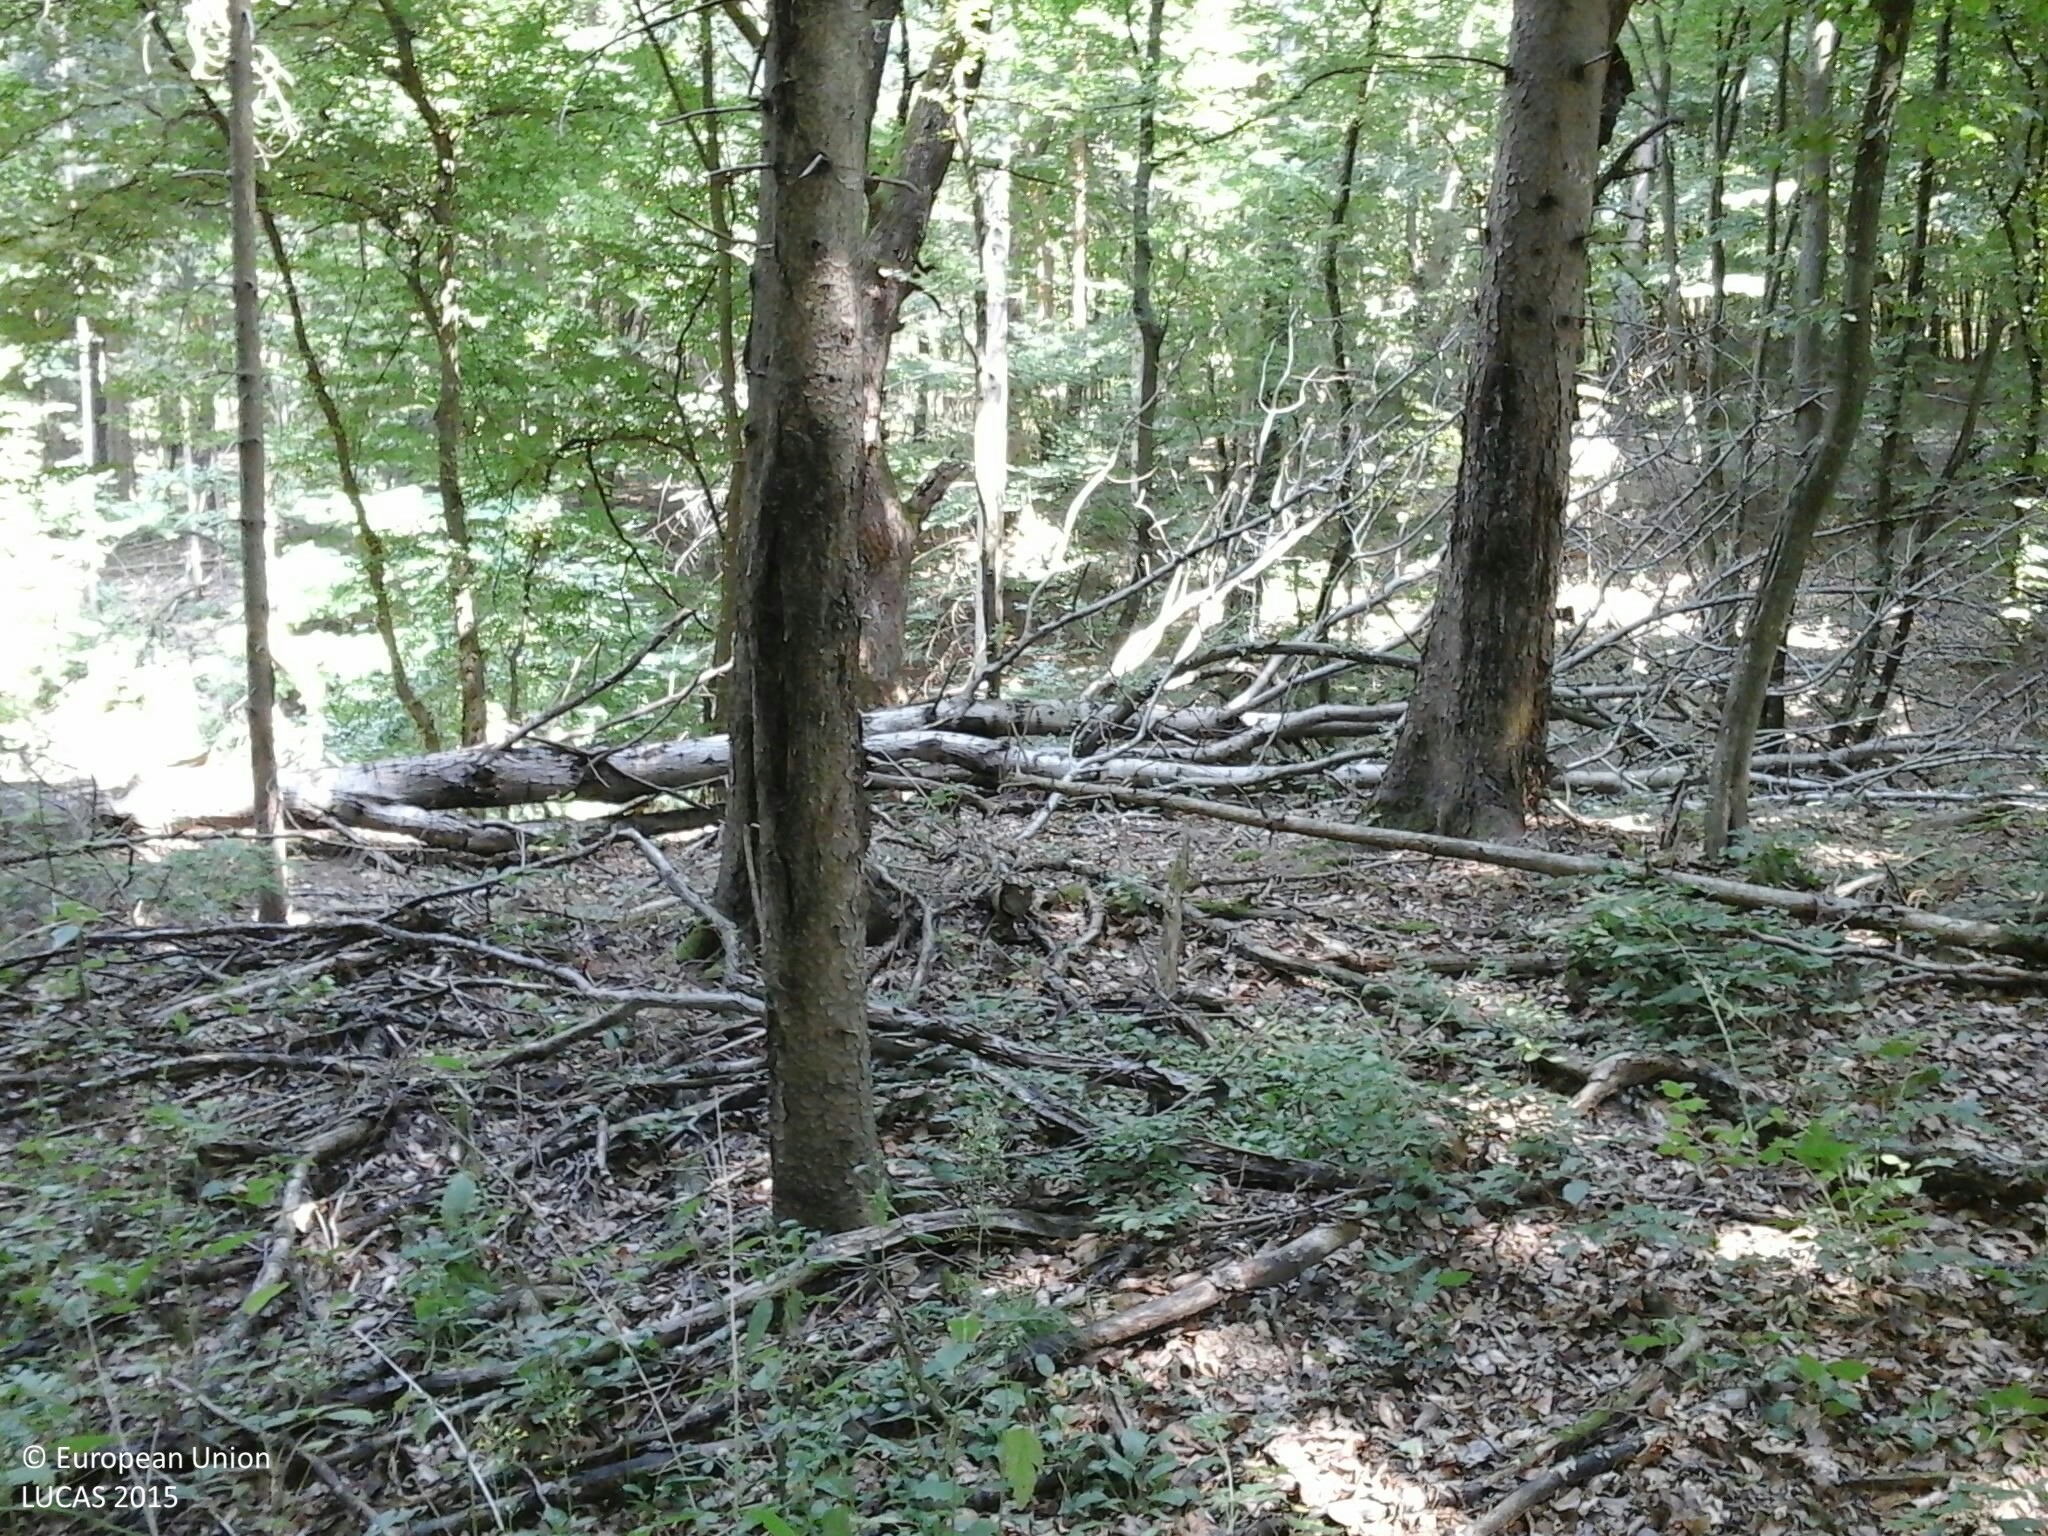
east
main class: Woodland
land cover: Spruce dominated coniferous woodland
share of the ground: > 75 %
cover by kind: coniferous forest trees 90 %, broadleaved forest trees 10 %
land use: Forestry
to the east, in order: Spruce dominated coniferous woodland; Pine dominated coniferous woodland; Broadleaved woodland; Tracks; Pine dominated coniferous woodland; Tracks; Pine dominated coniferous woodland; Tracks; Spruce dominated coniferous woodland
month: July
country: HU
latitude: 46.9347
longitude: 16.4252
